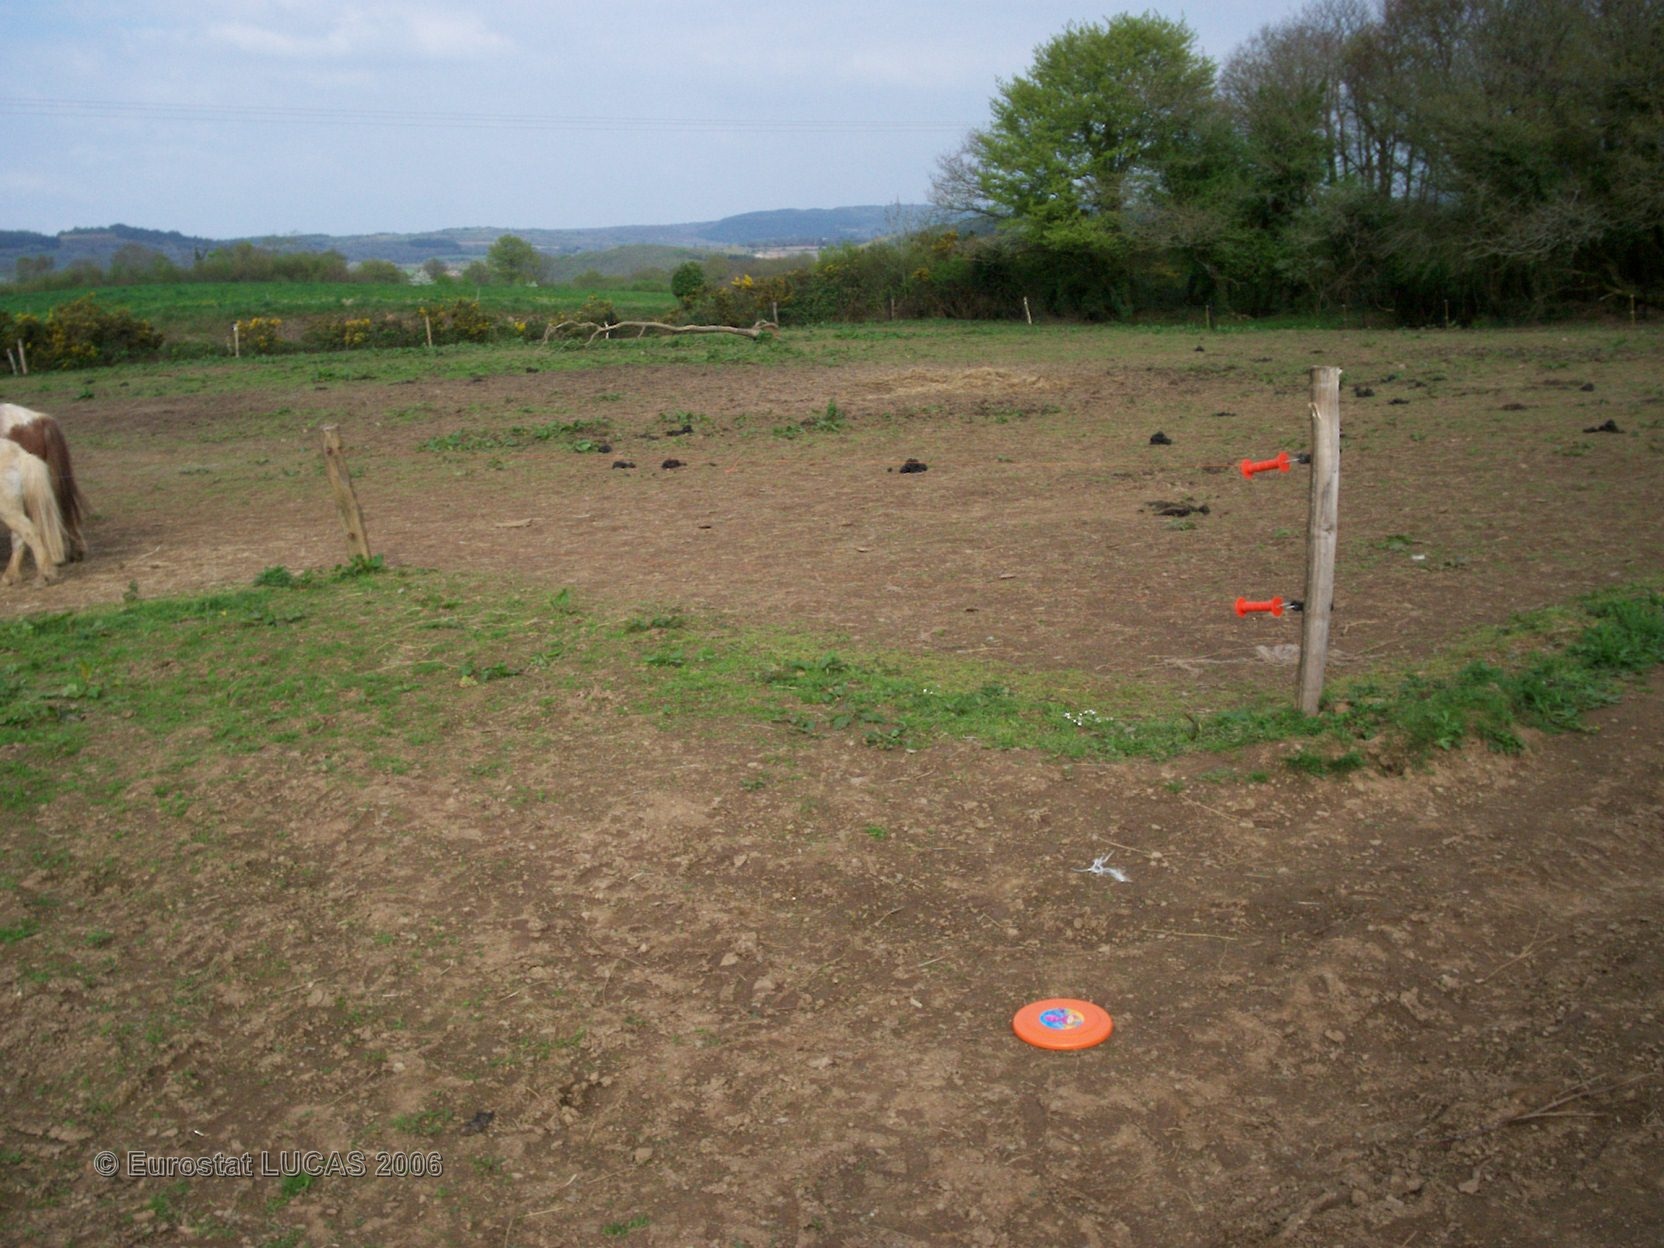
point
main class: Grassland
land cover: Grassland without tree/shrub cover
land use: Agriculture (excluding fallow land and kitchen gardens)
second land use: Amenities, museums, leisure
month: April
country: FR
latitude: 48.3154
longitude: -3.9630
